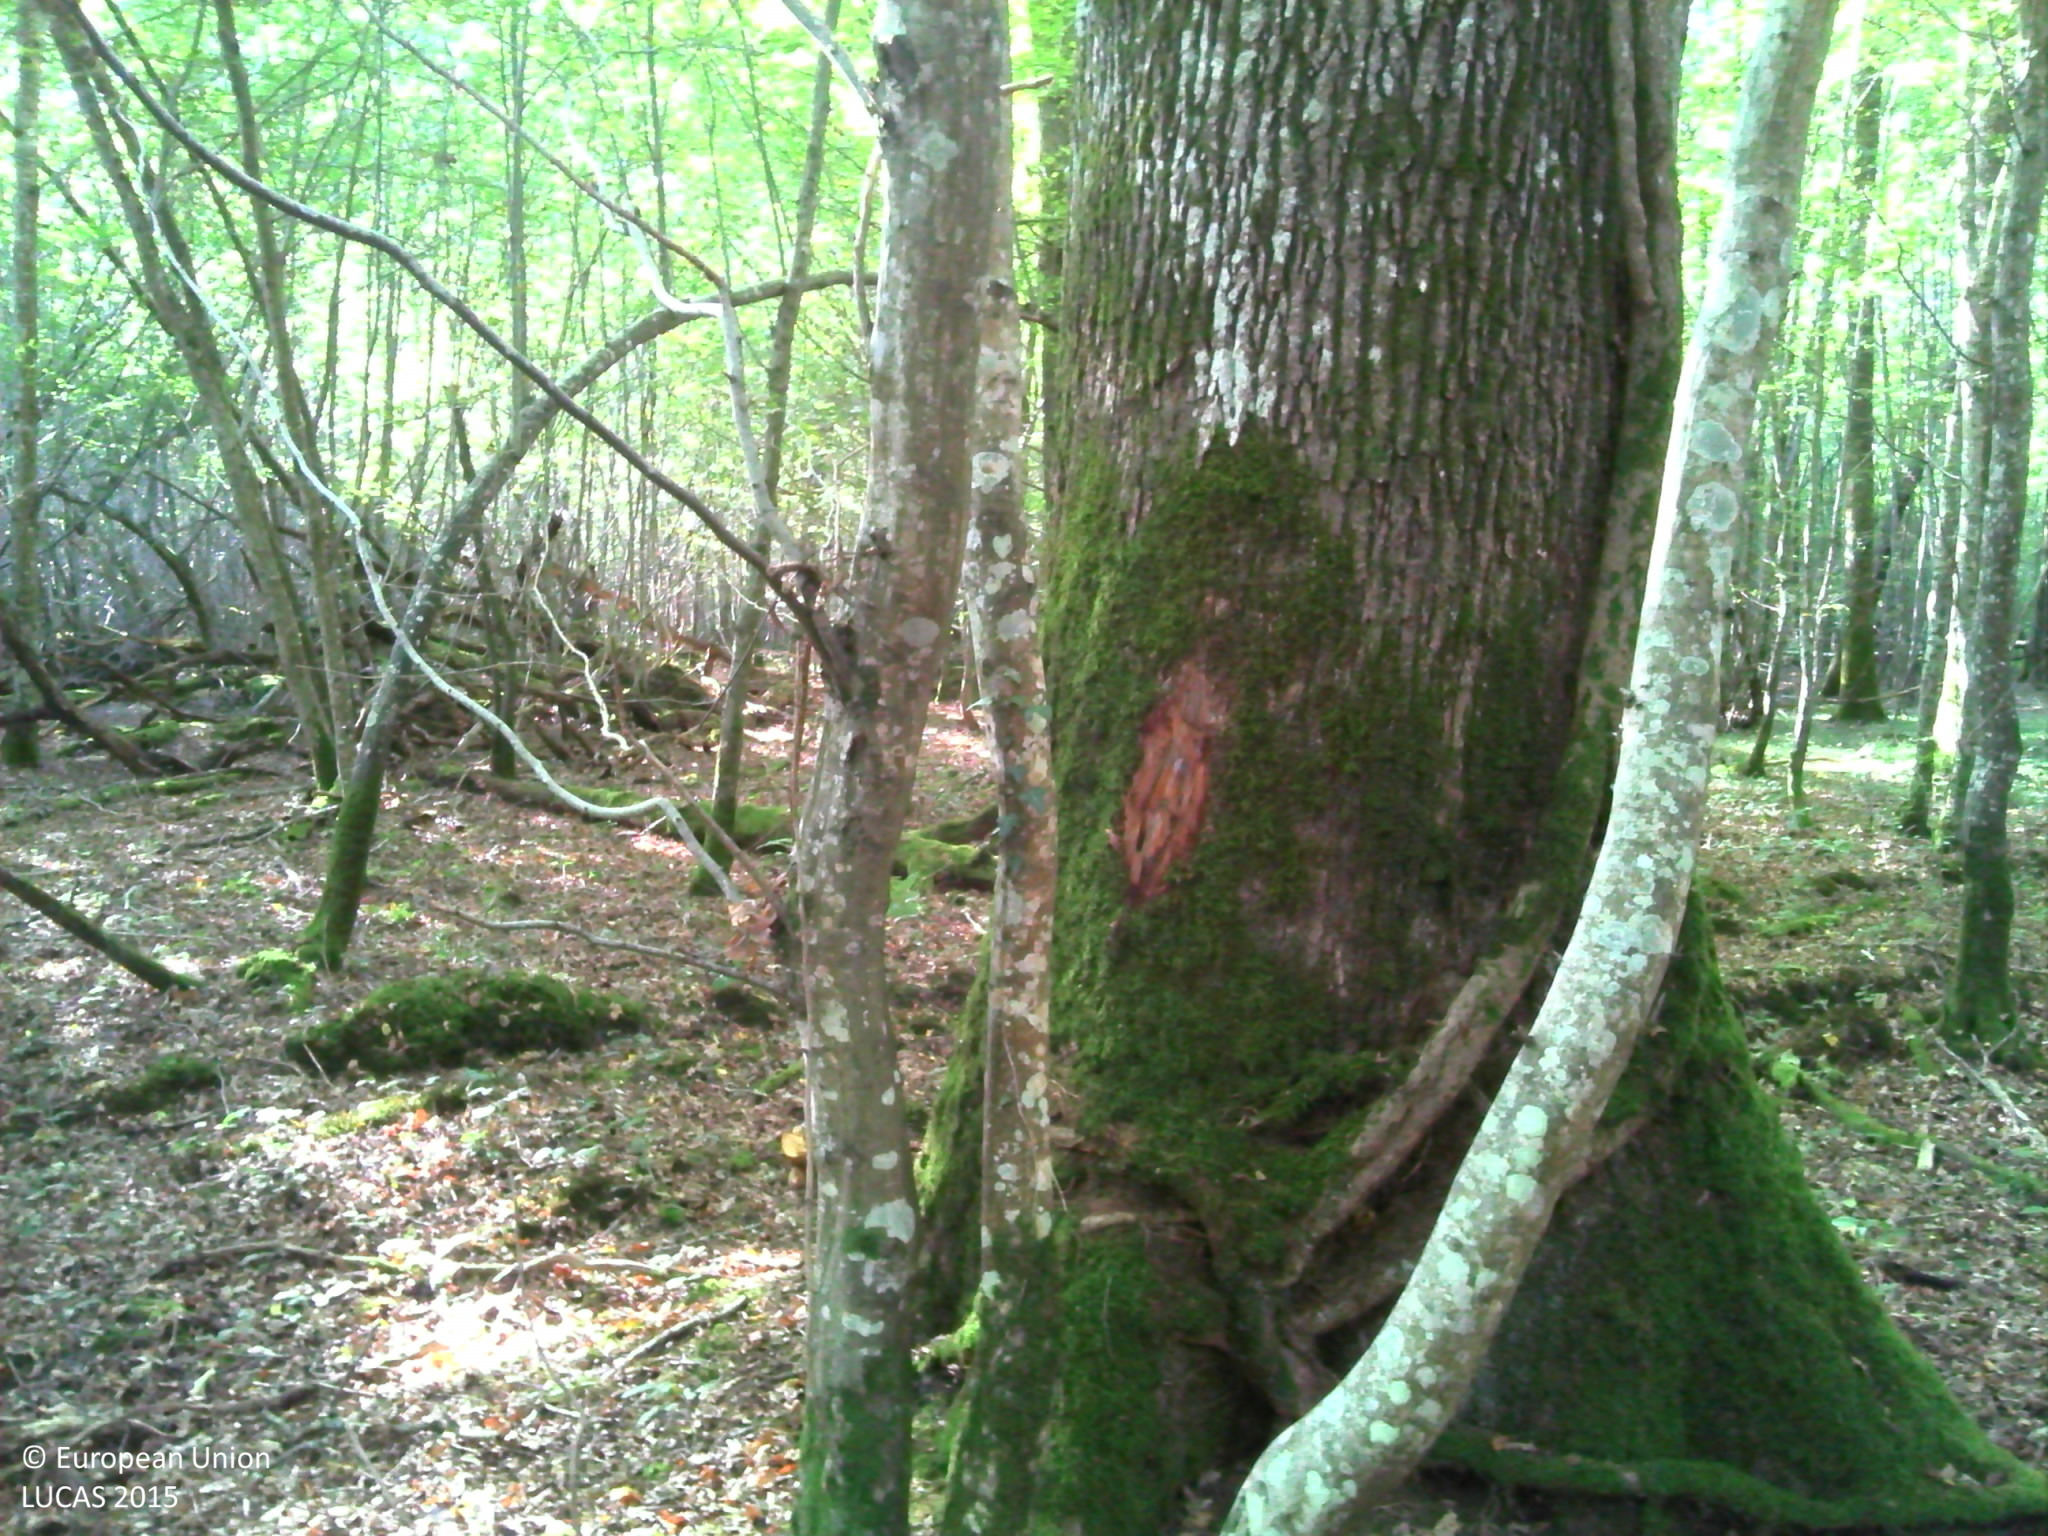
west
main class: Woodland
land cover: Broadleaved woodland
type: mesophytic deciduous forest
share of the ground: > 75 %
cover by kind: broadleaved forest trees 90 %, herbaceous plants 5 %, lichens and mosses 5 %
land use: Forestry
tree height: > 5 m
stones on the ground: < 10 %
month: September
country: FR
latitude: 48.1423
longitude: 3.8541
